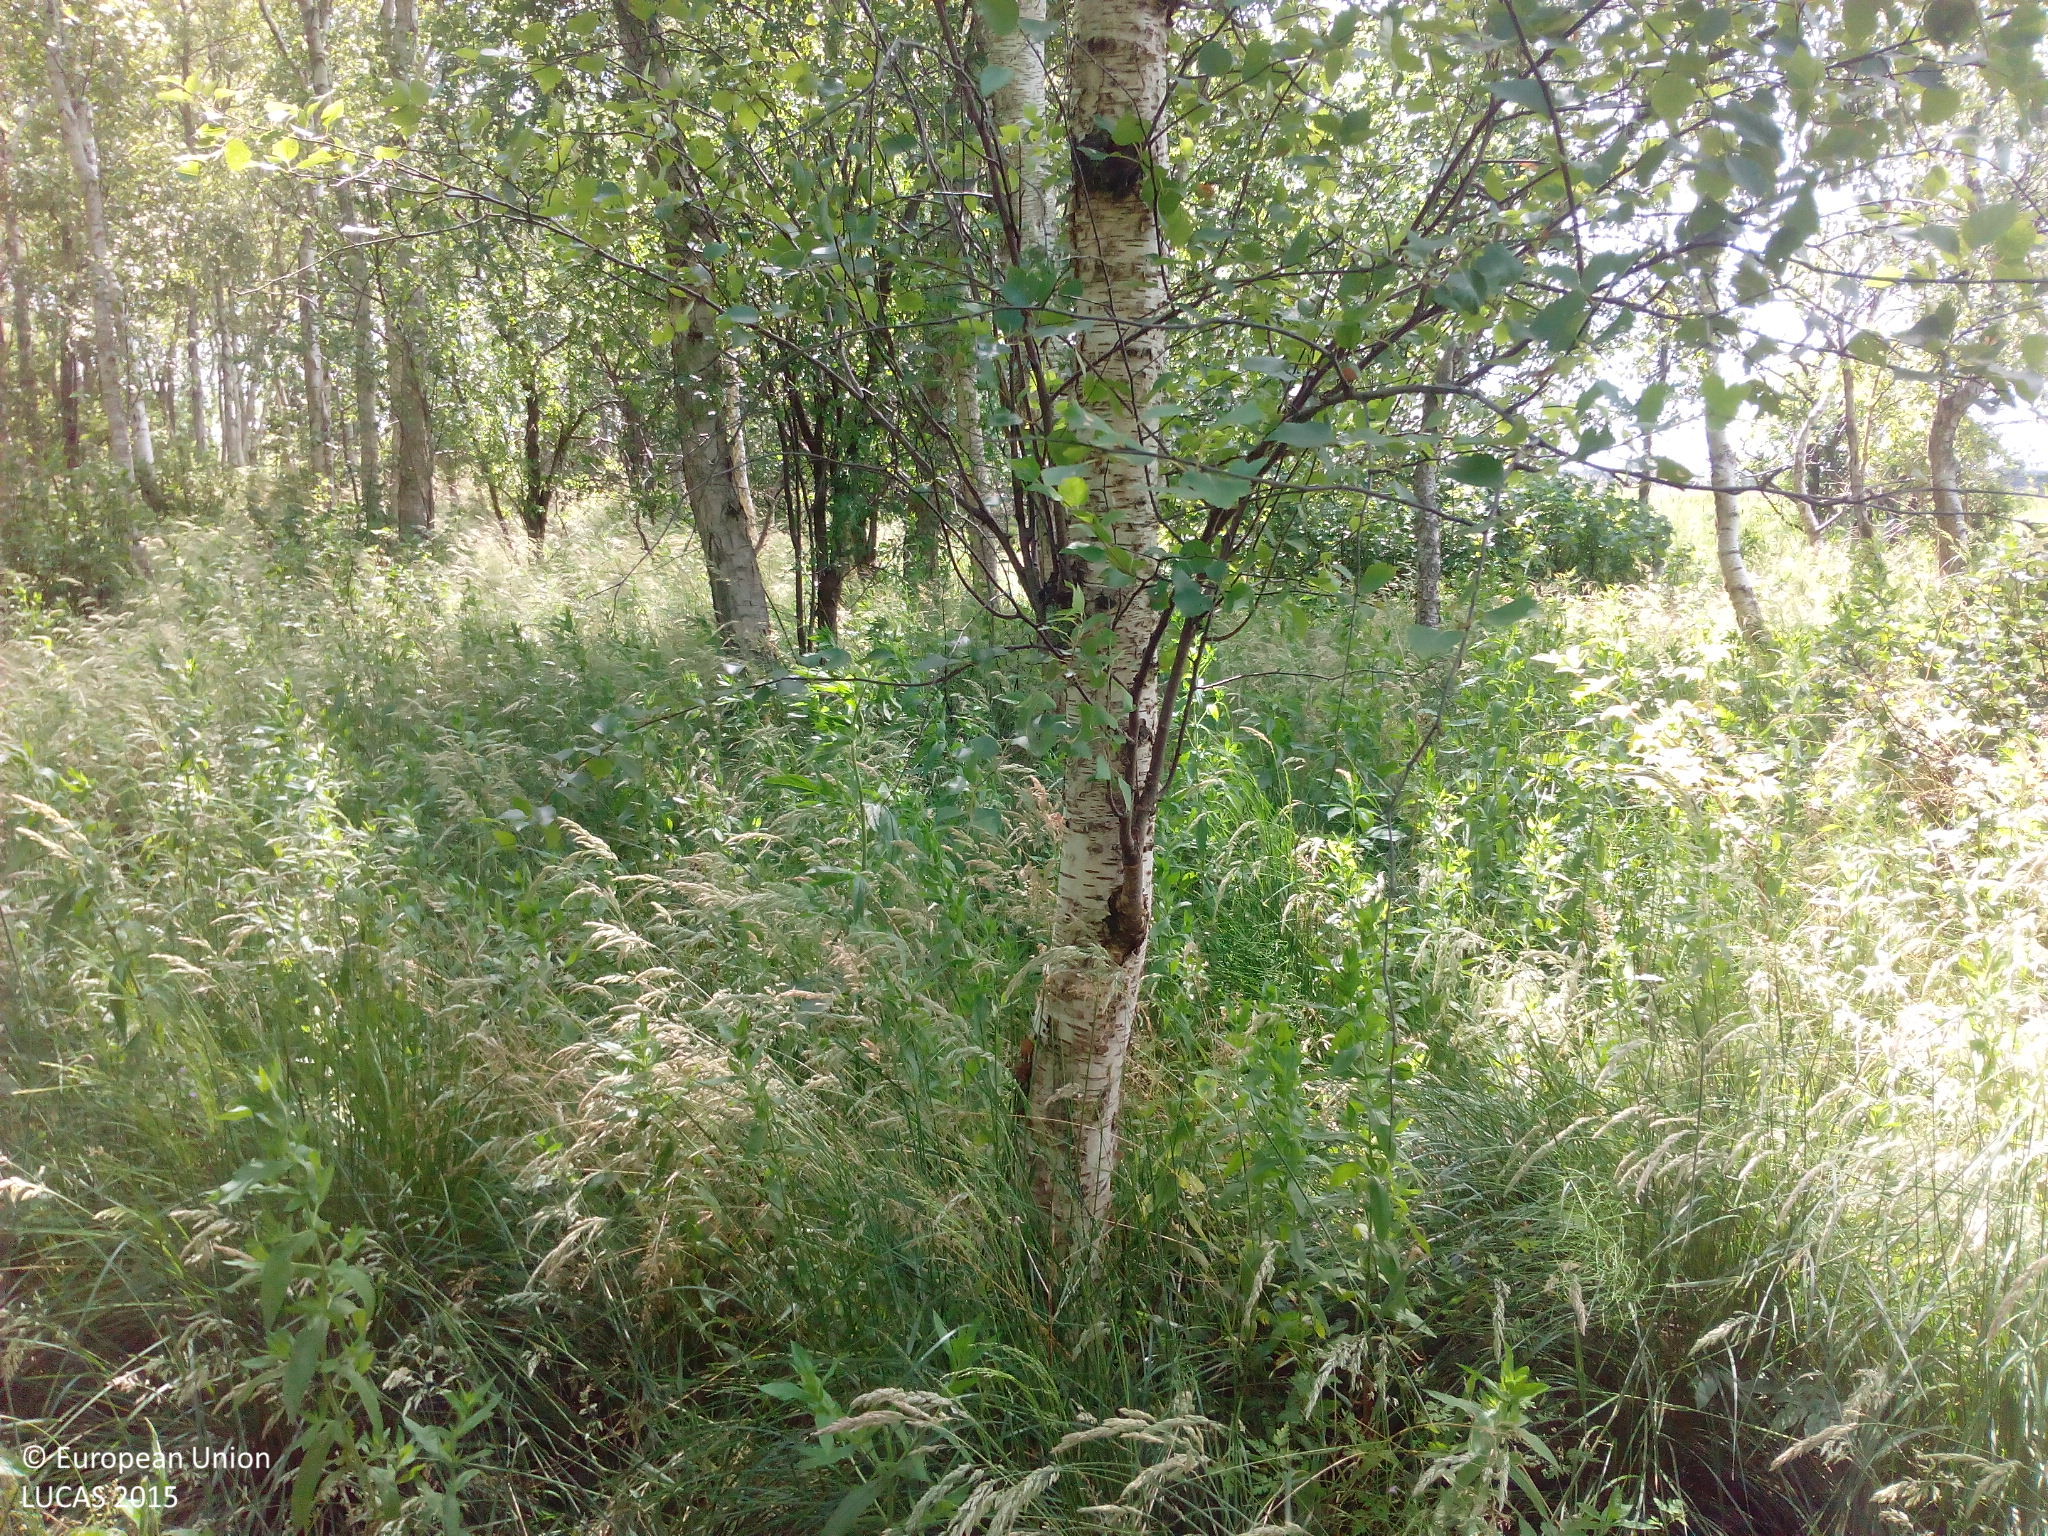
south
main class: Woodland
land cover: Broadleaved woodland
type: mesophytic deciduous forest
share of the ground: > 75 %
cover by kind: broadleaved forest trees 80 %, herbaceous plants 15 %, shrubs 5 %
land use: Semi-natural and natural areas not in use
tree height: > 5 m
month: July
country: DE
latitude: 53.9692
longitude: 13.2769
